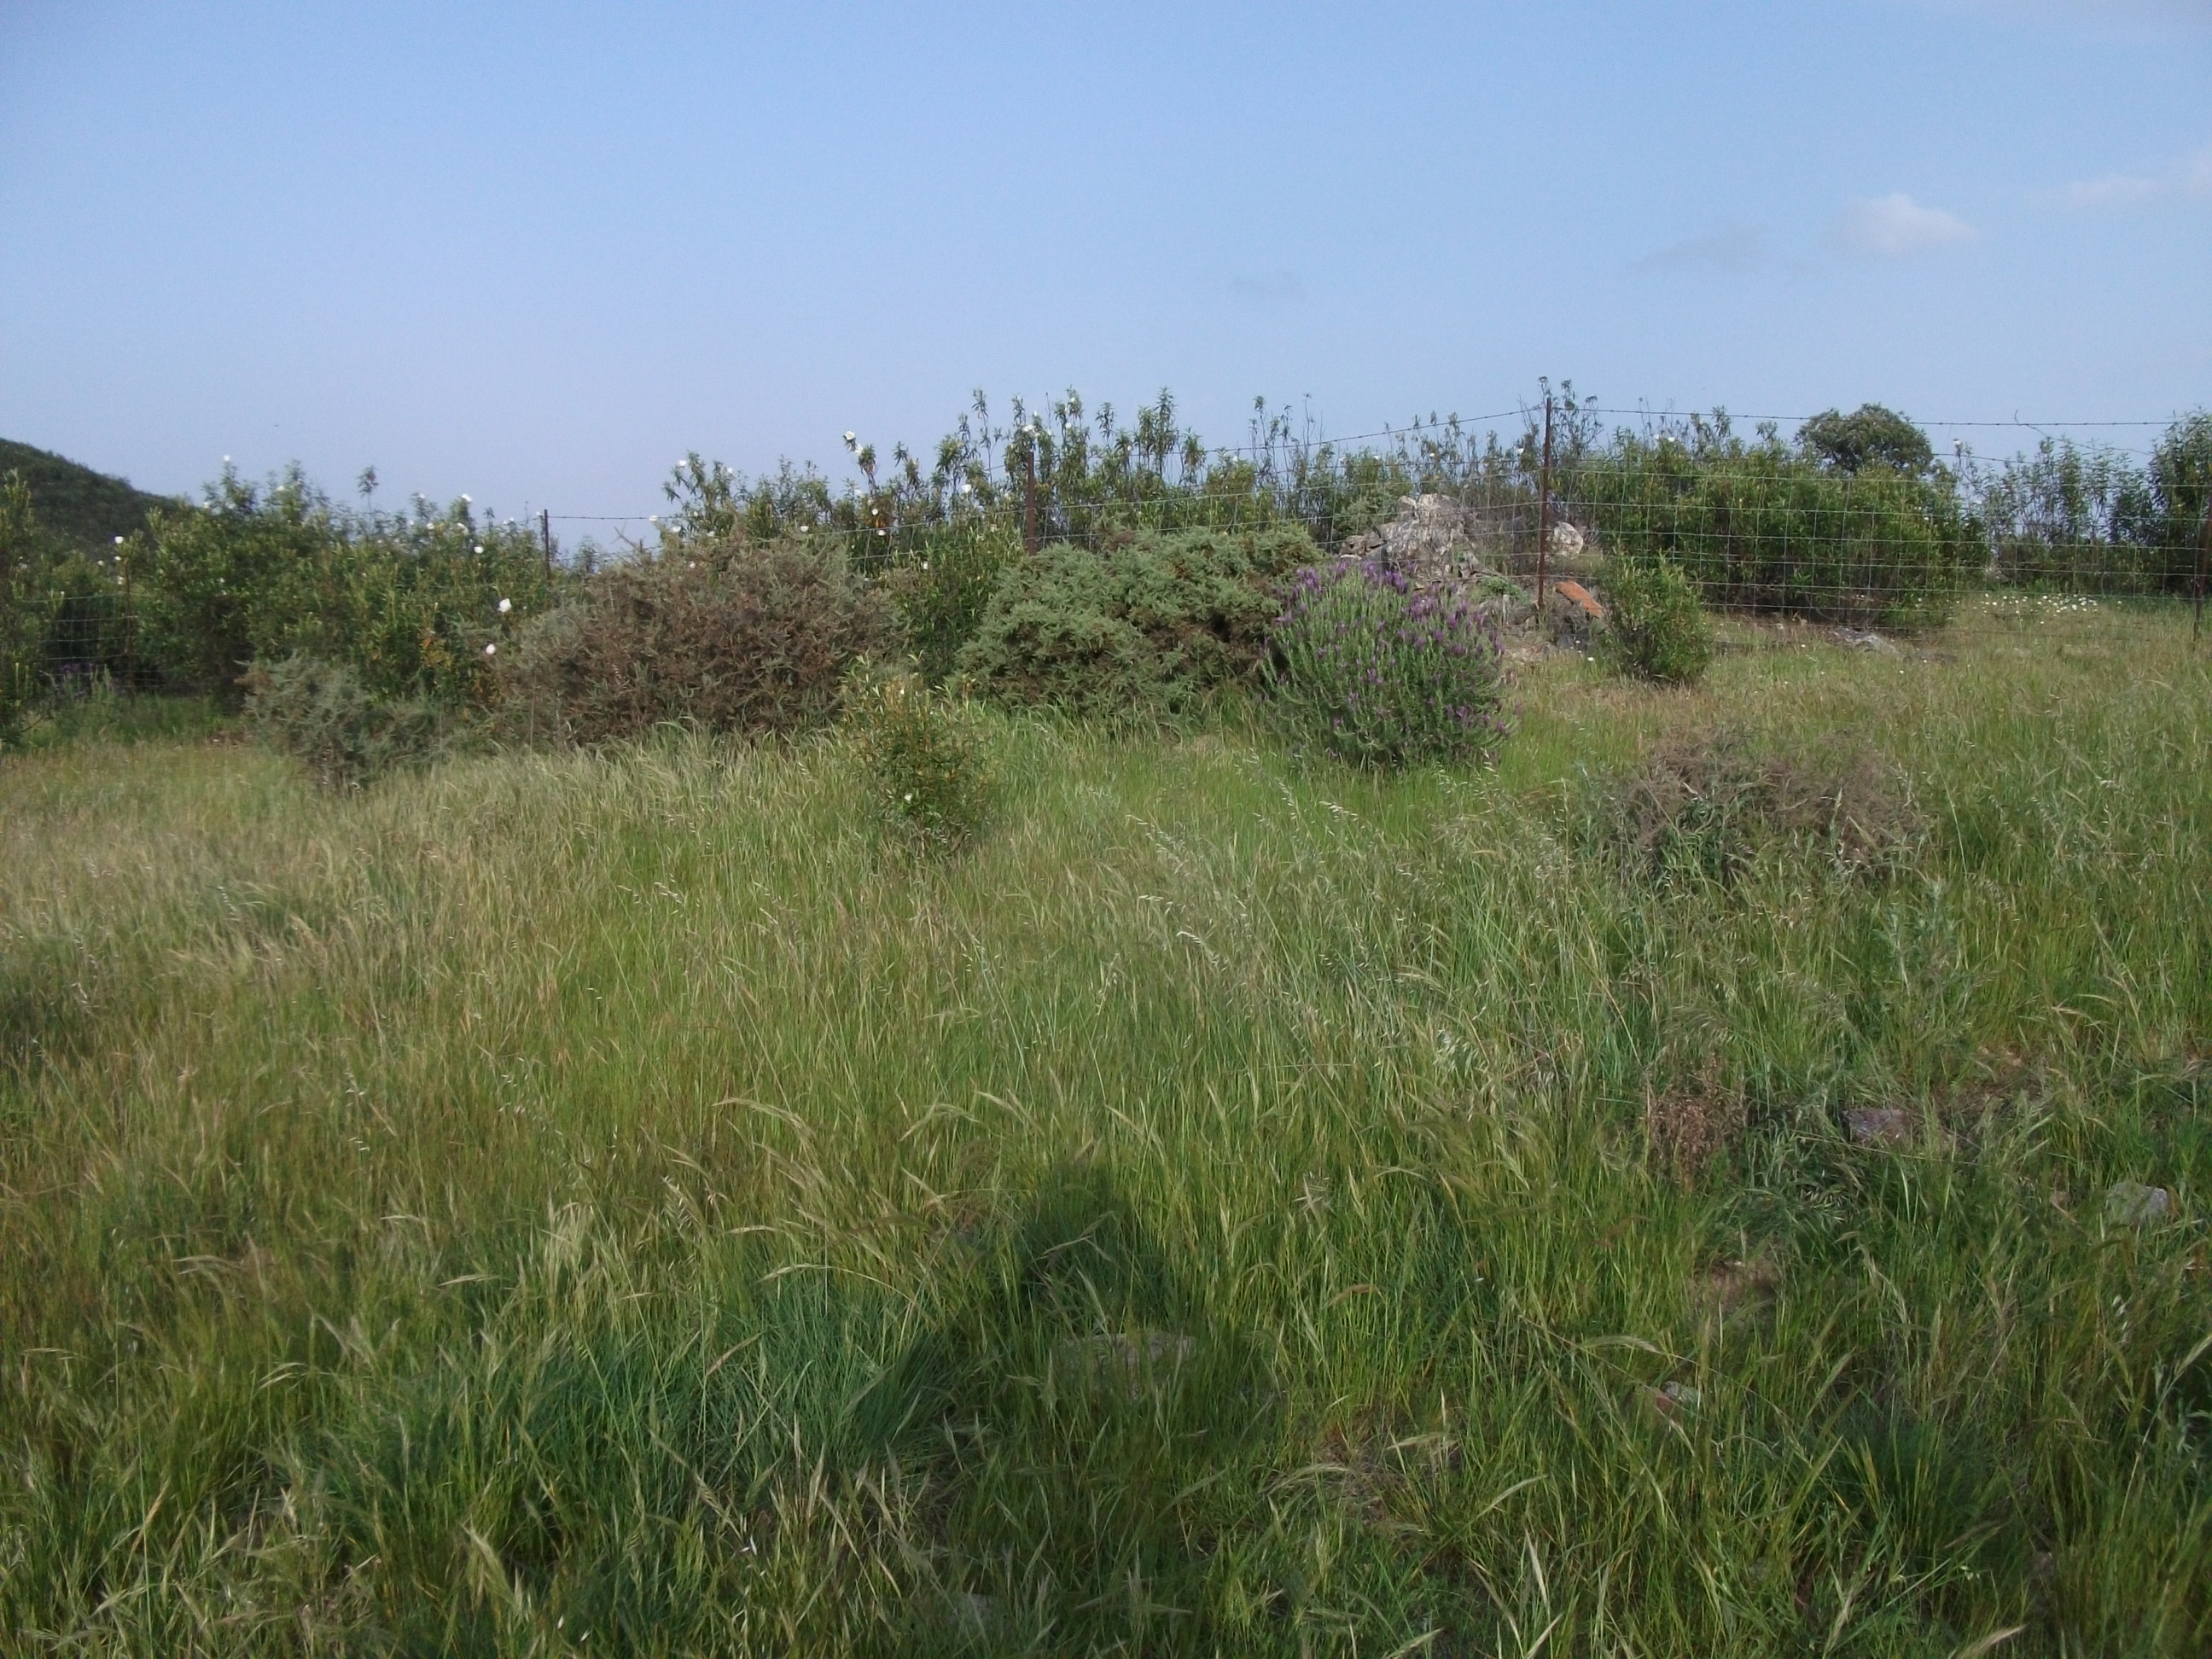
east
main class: Grassland
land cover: Grassland without tree/shrub cover
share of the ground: > 75 %
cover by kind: herbaceous plants 95 %, shrubs 5 %
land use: Agriculture (excluding fallow land and kitchen gardens)
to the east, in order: Grassland without tree/shrub cover; Fences; Shrubland without tree cover; Grassland without tree/shrub cover; Shrubland without tree cover
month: April
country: ES
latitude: 37.7559
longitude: -6.6943
